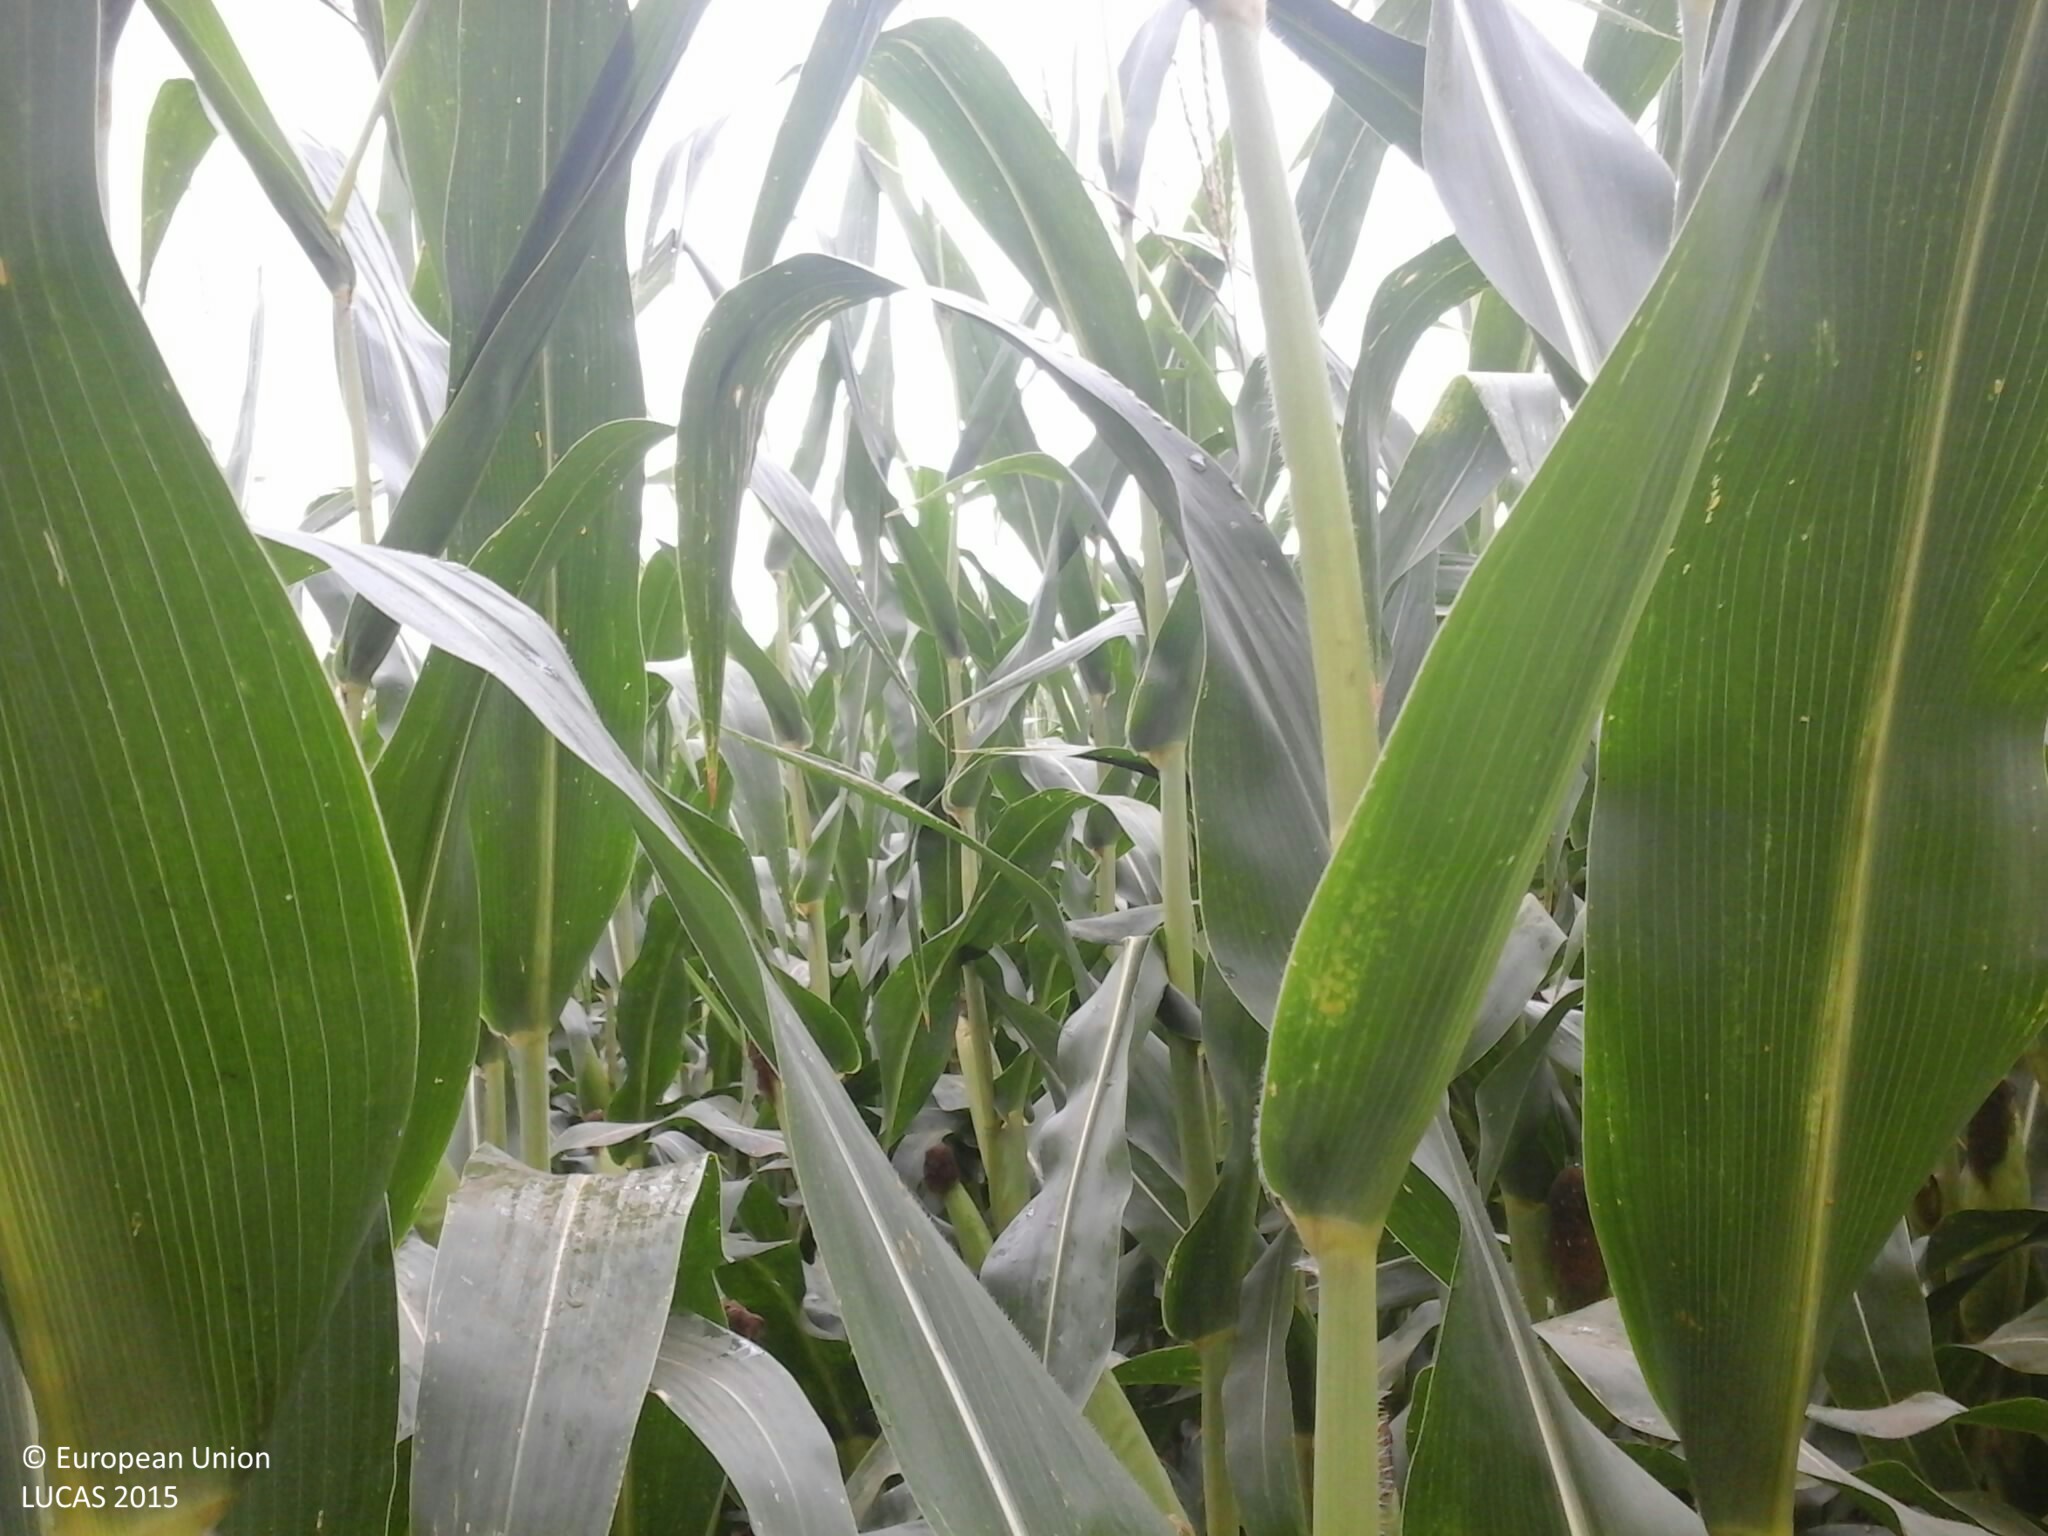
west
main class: Cropland
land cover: Maize
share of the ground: > 75 %
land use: Agriculture (excluding fallow land and kitchen gardens)
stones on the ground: < 10 %
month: July
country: HU
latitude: 46.7471
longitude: 17.6376
